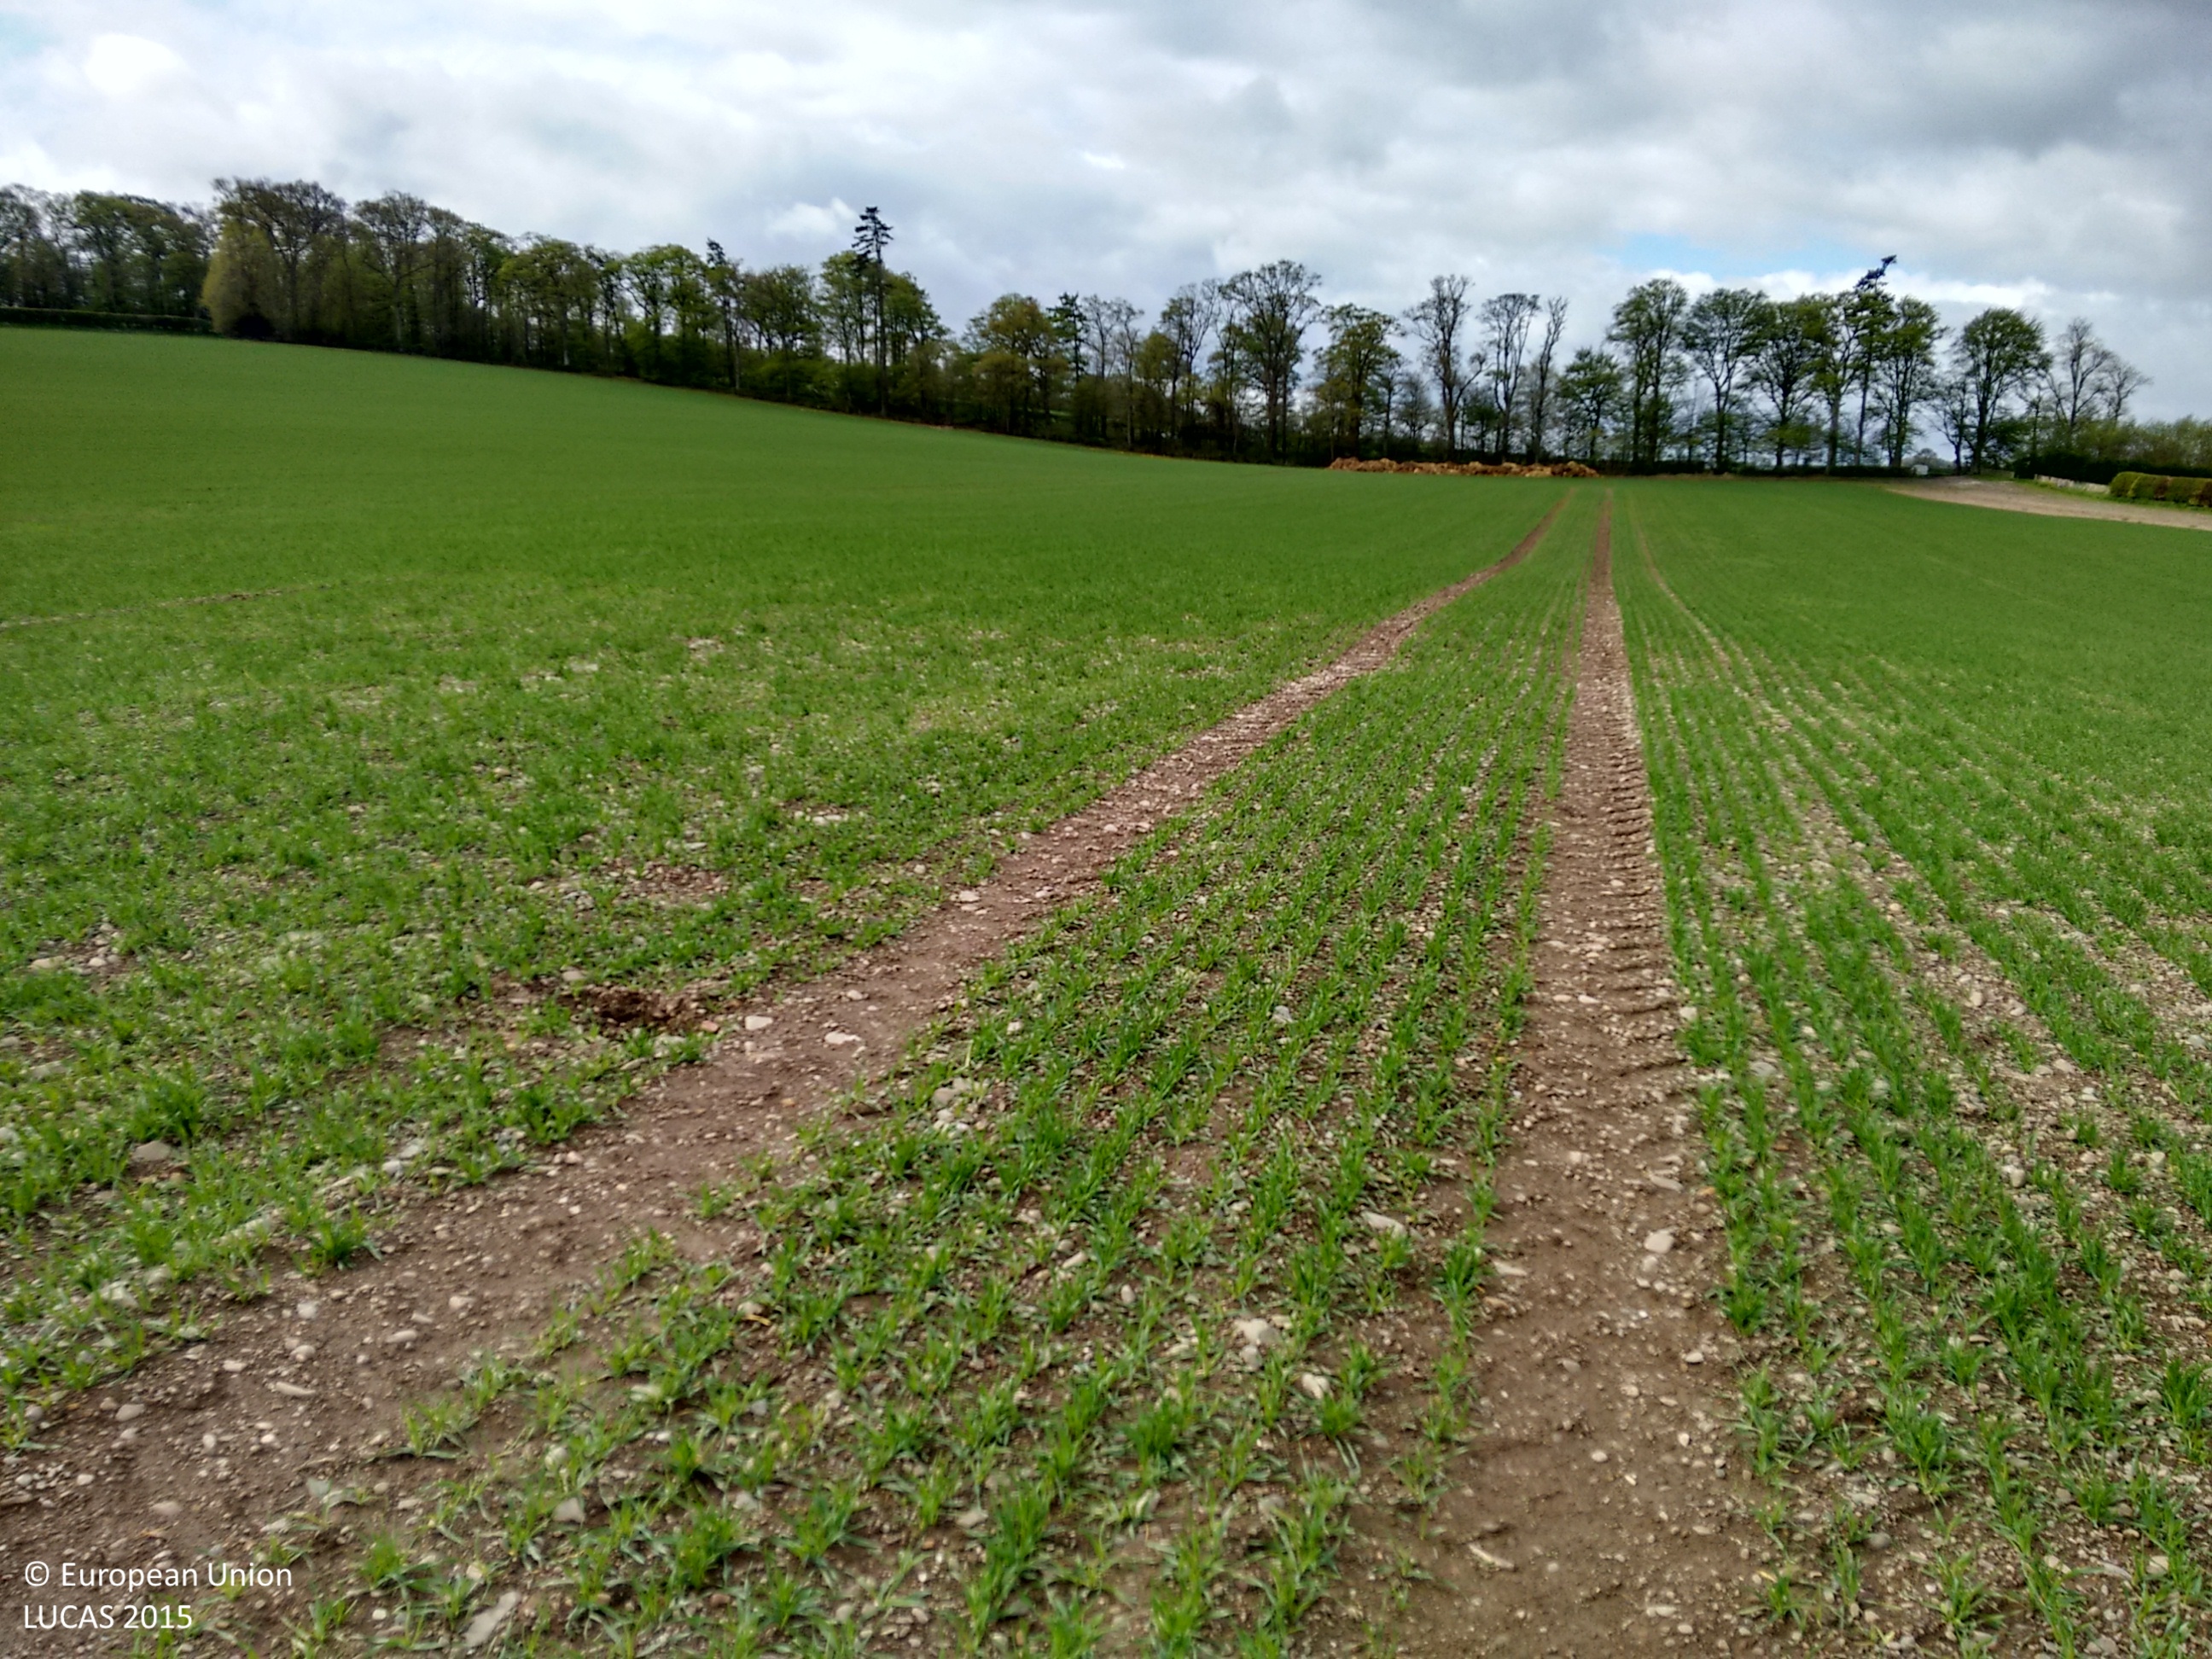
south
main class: Cropland
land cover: Barley
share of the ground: 50 - 75 %
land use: Agriculture (excluding fallow land and kitchen gardens)
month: May
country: GB
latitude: 55.5599
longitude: -2.6360
